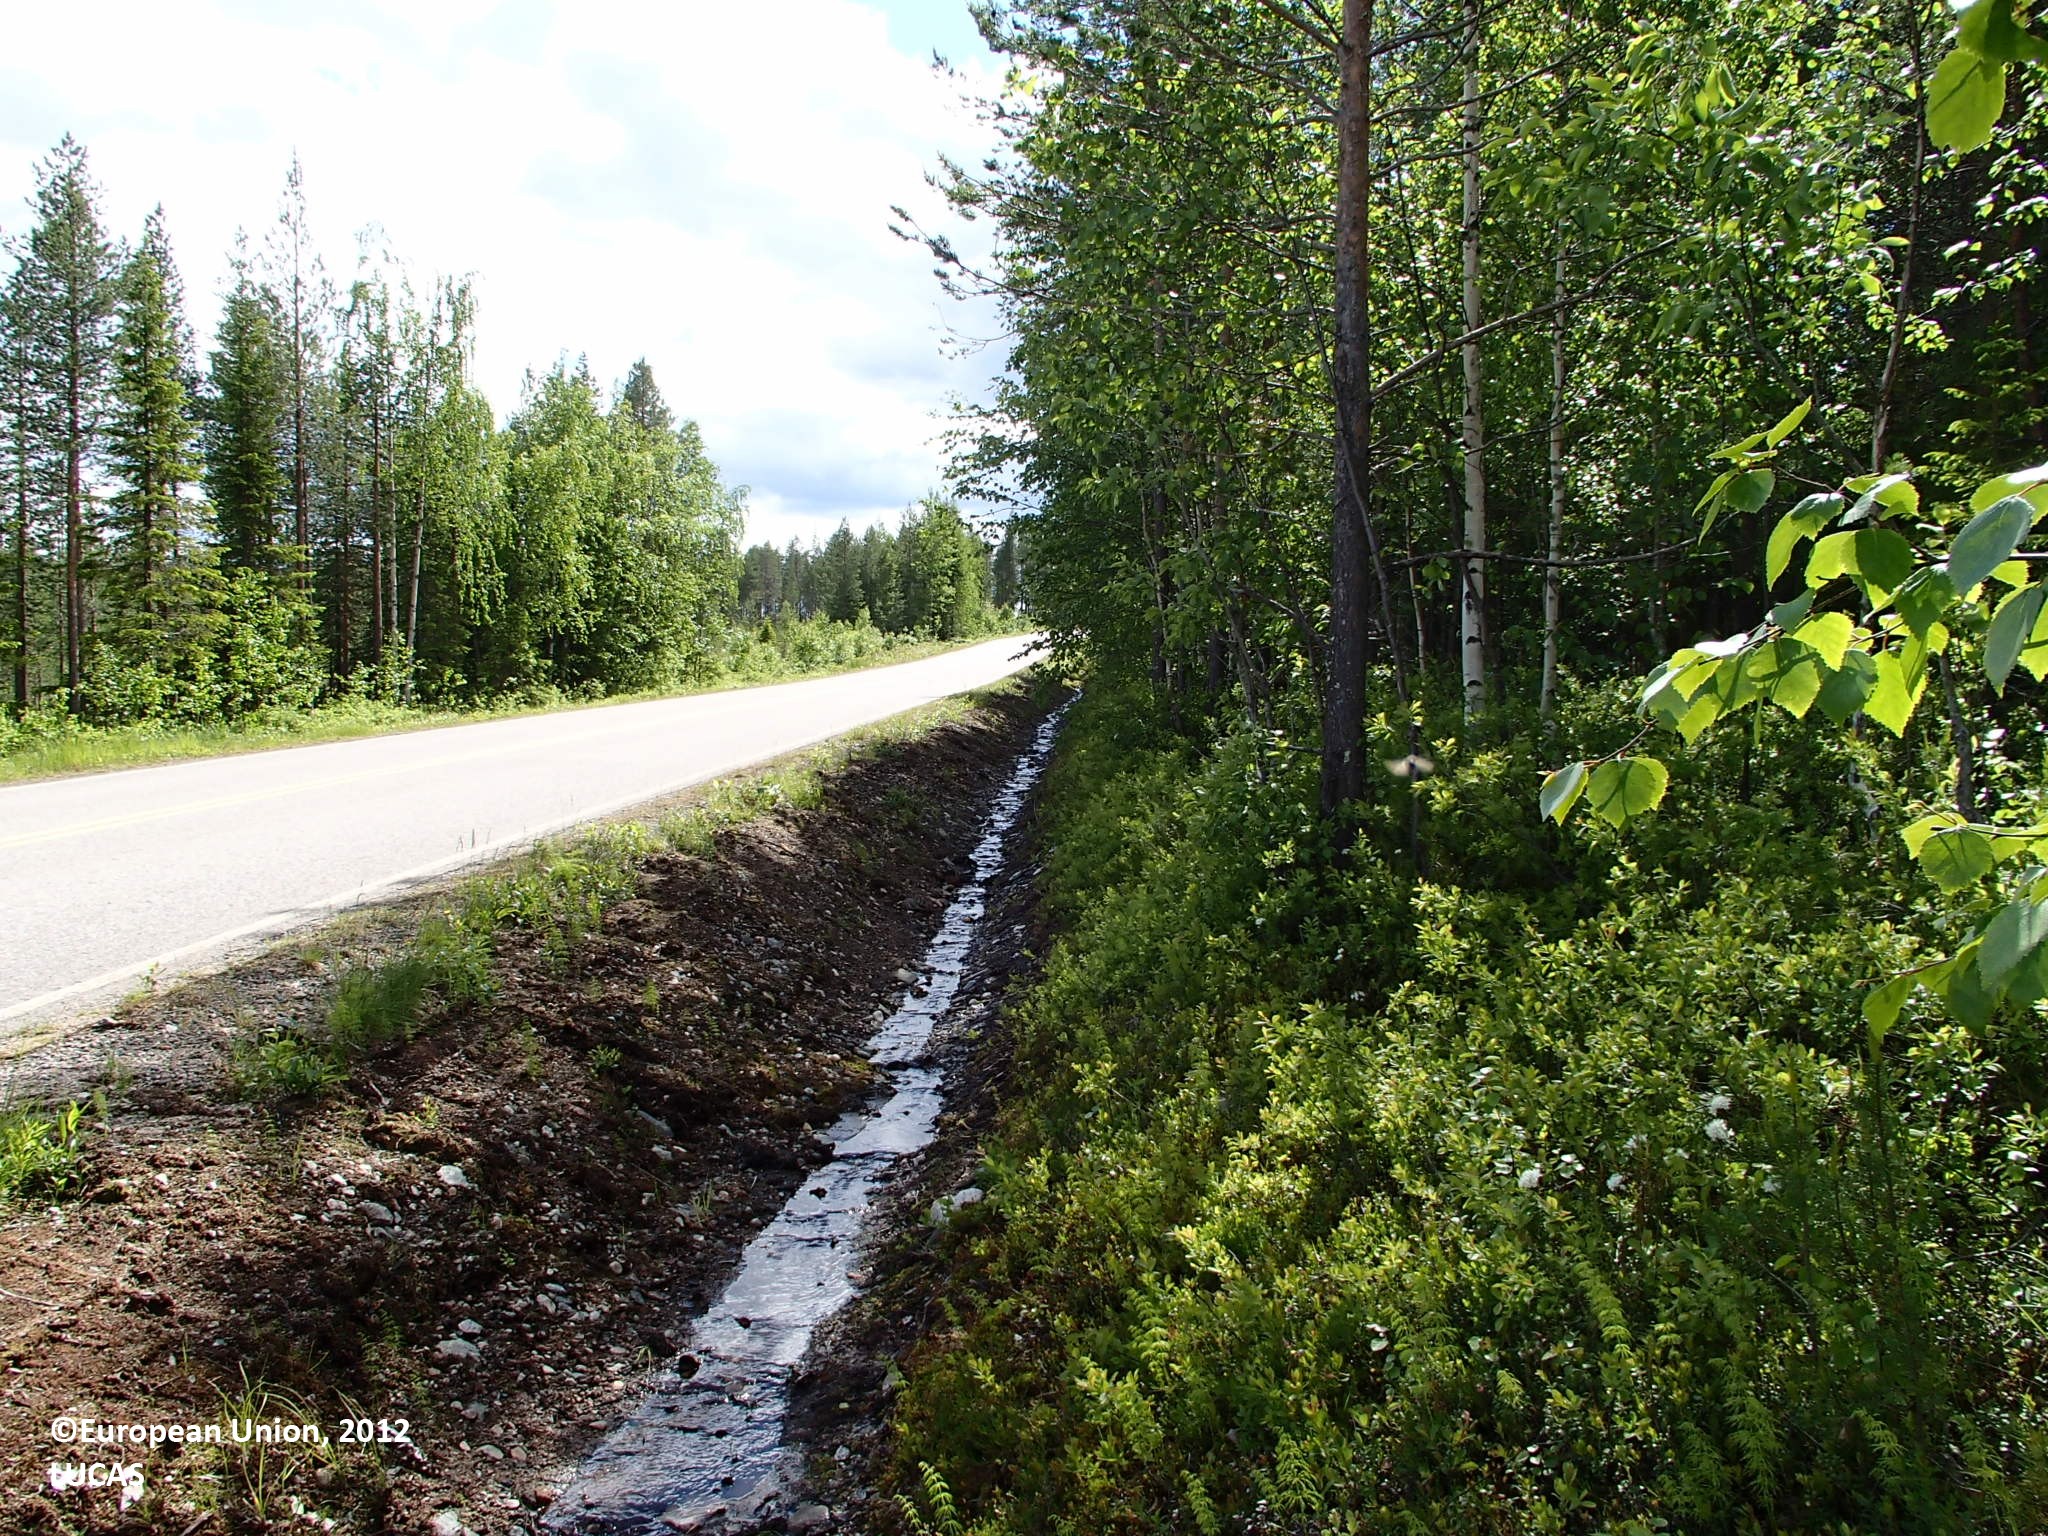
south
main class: Woodland
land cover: Other mixed woodland
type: boreal forest
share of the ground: > 75 %
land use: Forestry
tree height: > 5 m
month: June
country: FI
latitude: 66.6522
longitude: 27.3608
